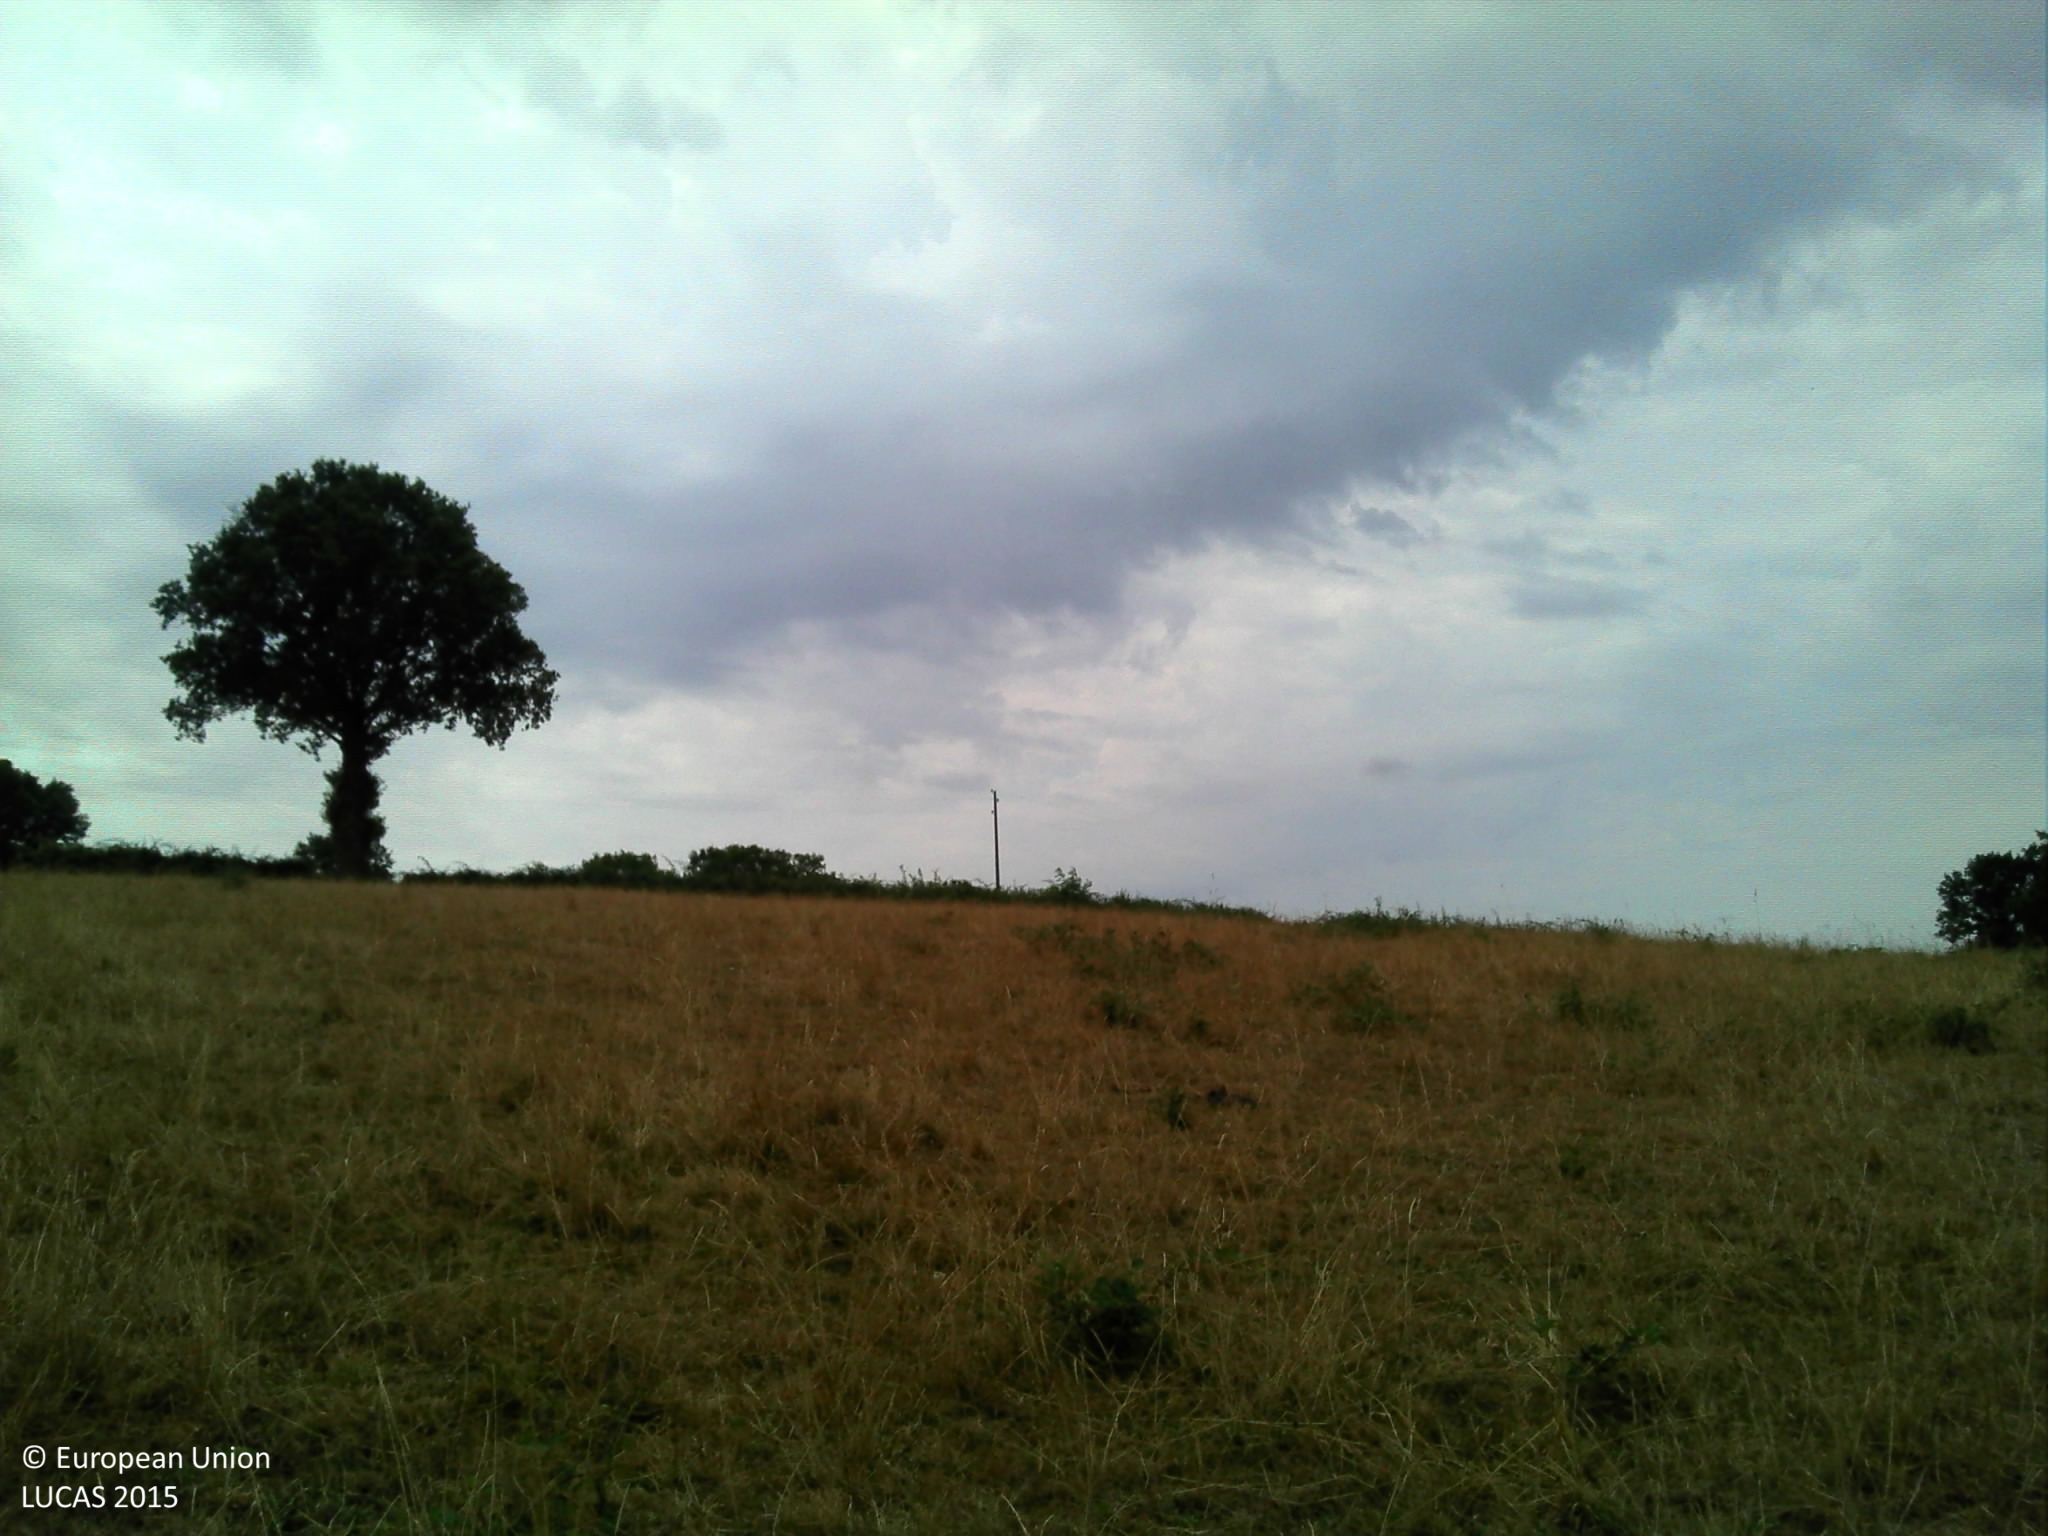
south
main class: Grassland
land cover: Grassland without tree/shrub cover
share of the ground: > 75 %
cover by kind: herbaceous plants 100 %
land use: Agriculture (excluding fallow land and kitchen gardens)
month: July
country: FR
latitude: 46.6268
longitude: 2.9831
